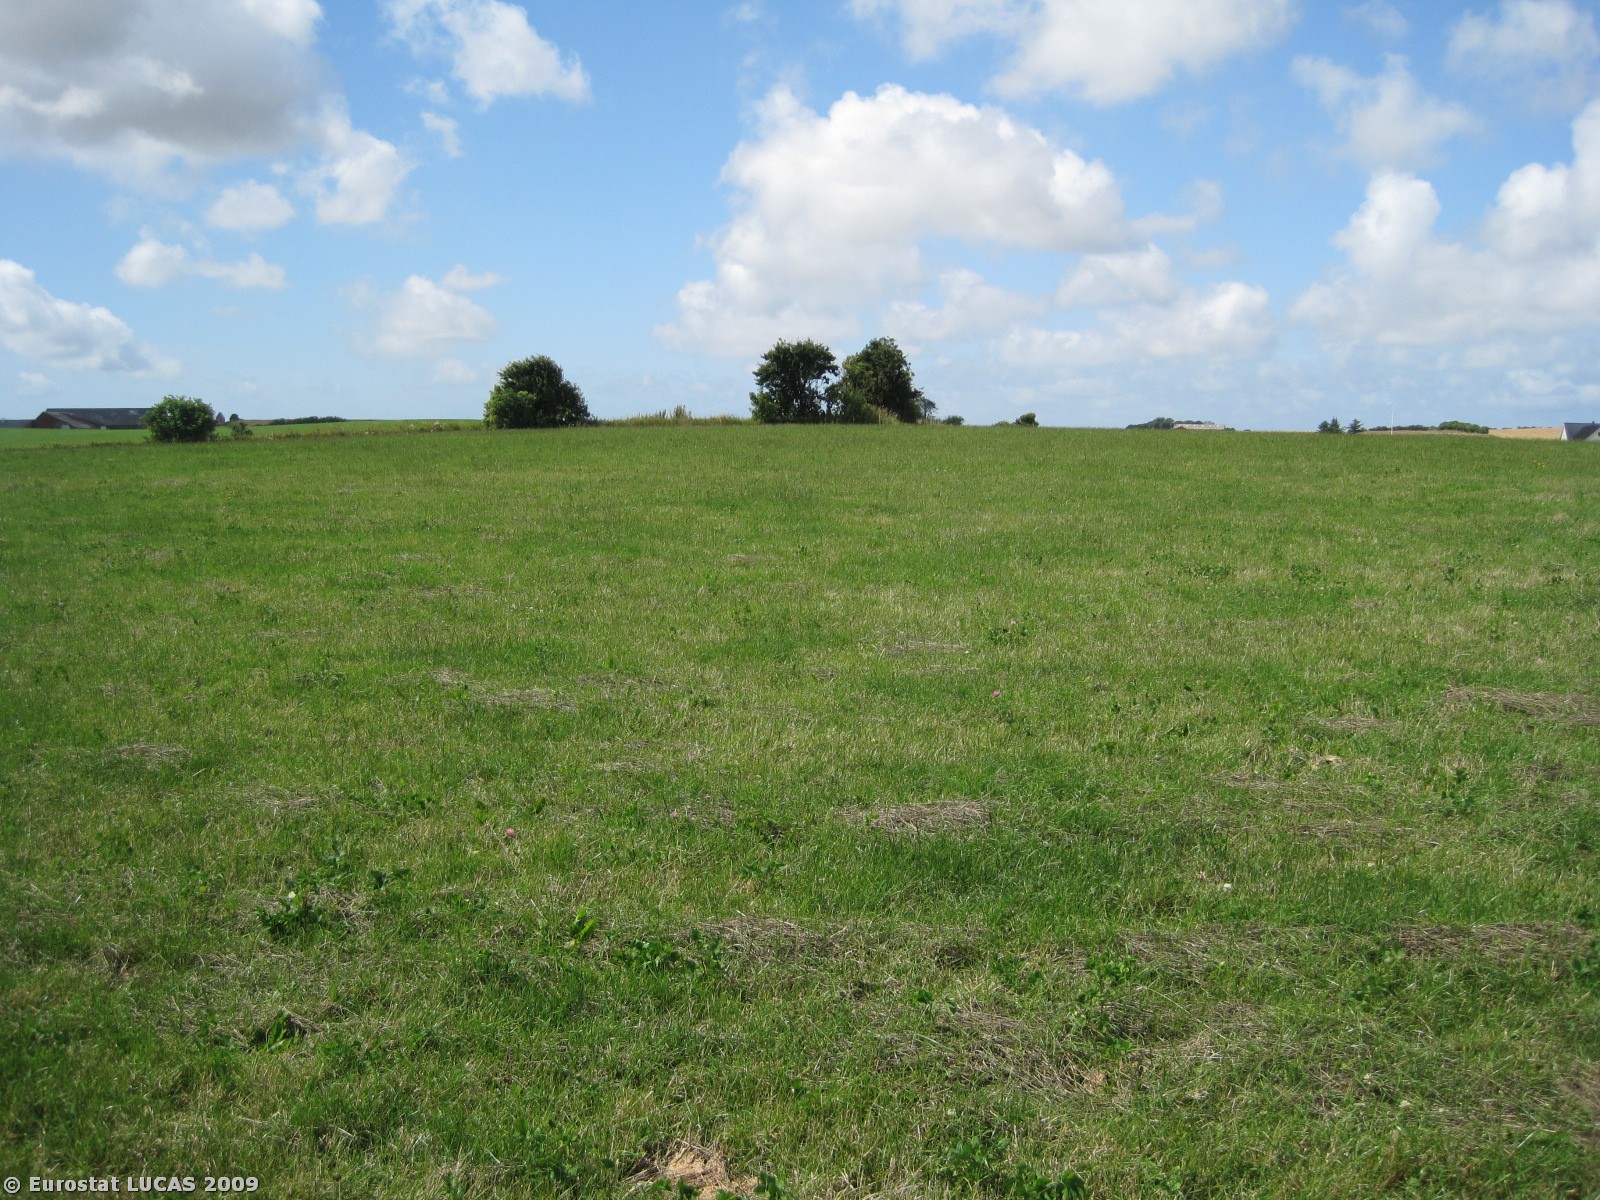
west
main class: Grassland
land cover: Grassland without tree/shrub cover
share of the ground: > 75 %
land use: Agriculture (excluding fallow land and kitchen gardens)
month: July
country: DK
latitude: 56.8252
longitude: 8.4127
